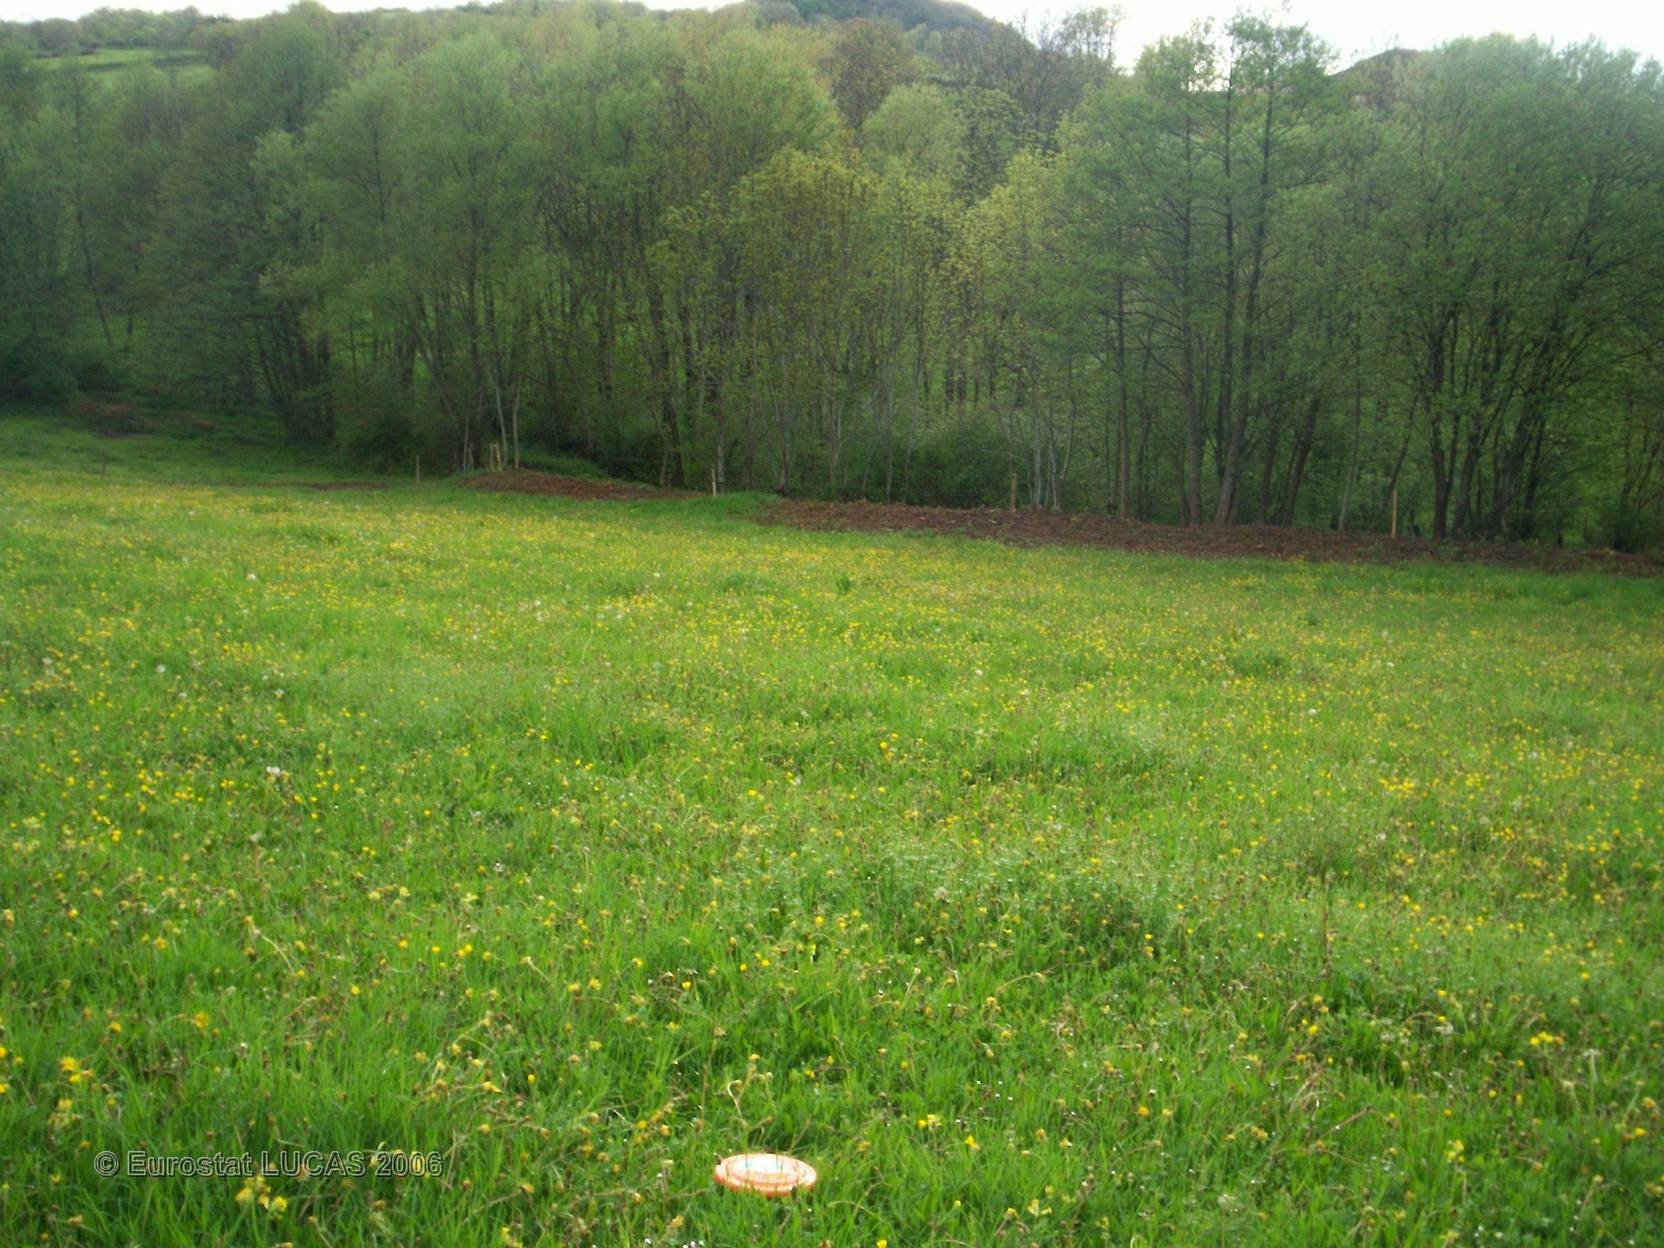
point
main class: Grassland
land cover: Grassland without tree/shrub cover
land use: Agriculture (excluding fallow land and kitchen gardens)
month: May
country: FR
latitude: 45.5299
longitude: 3.0733
